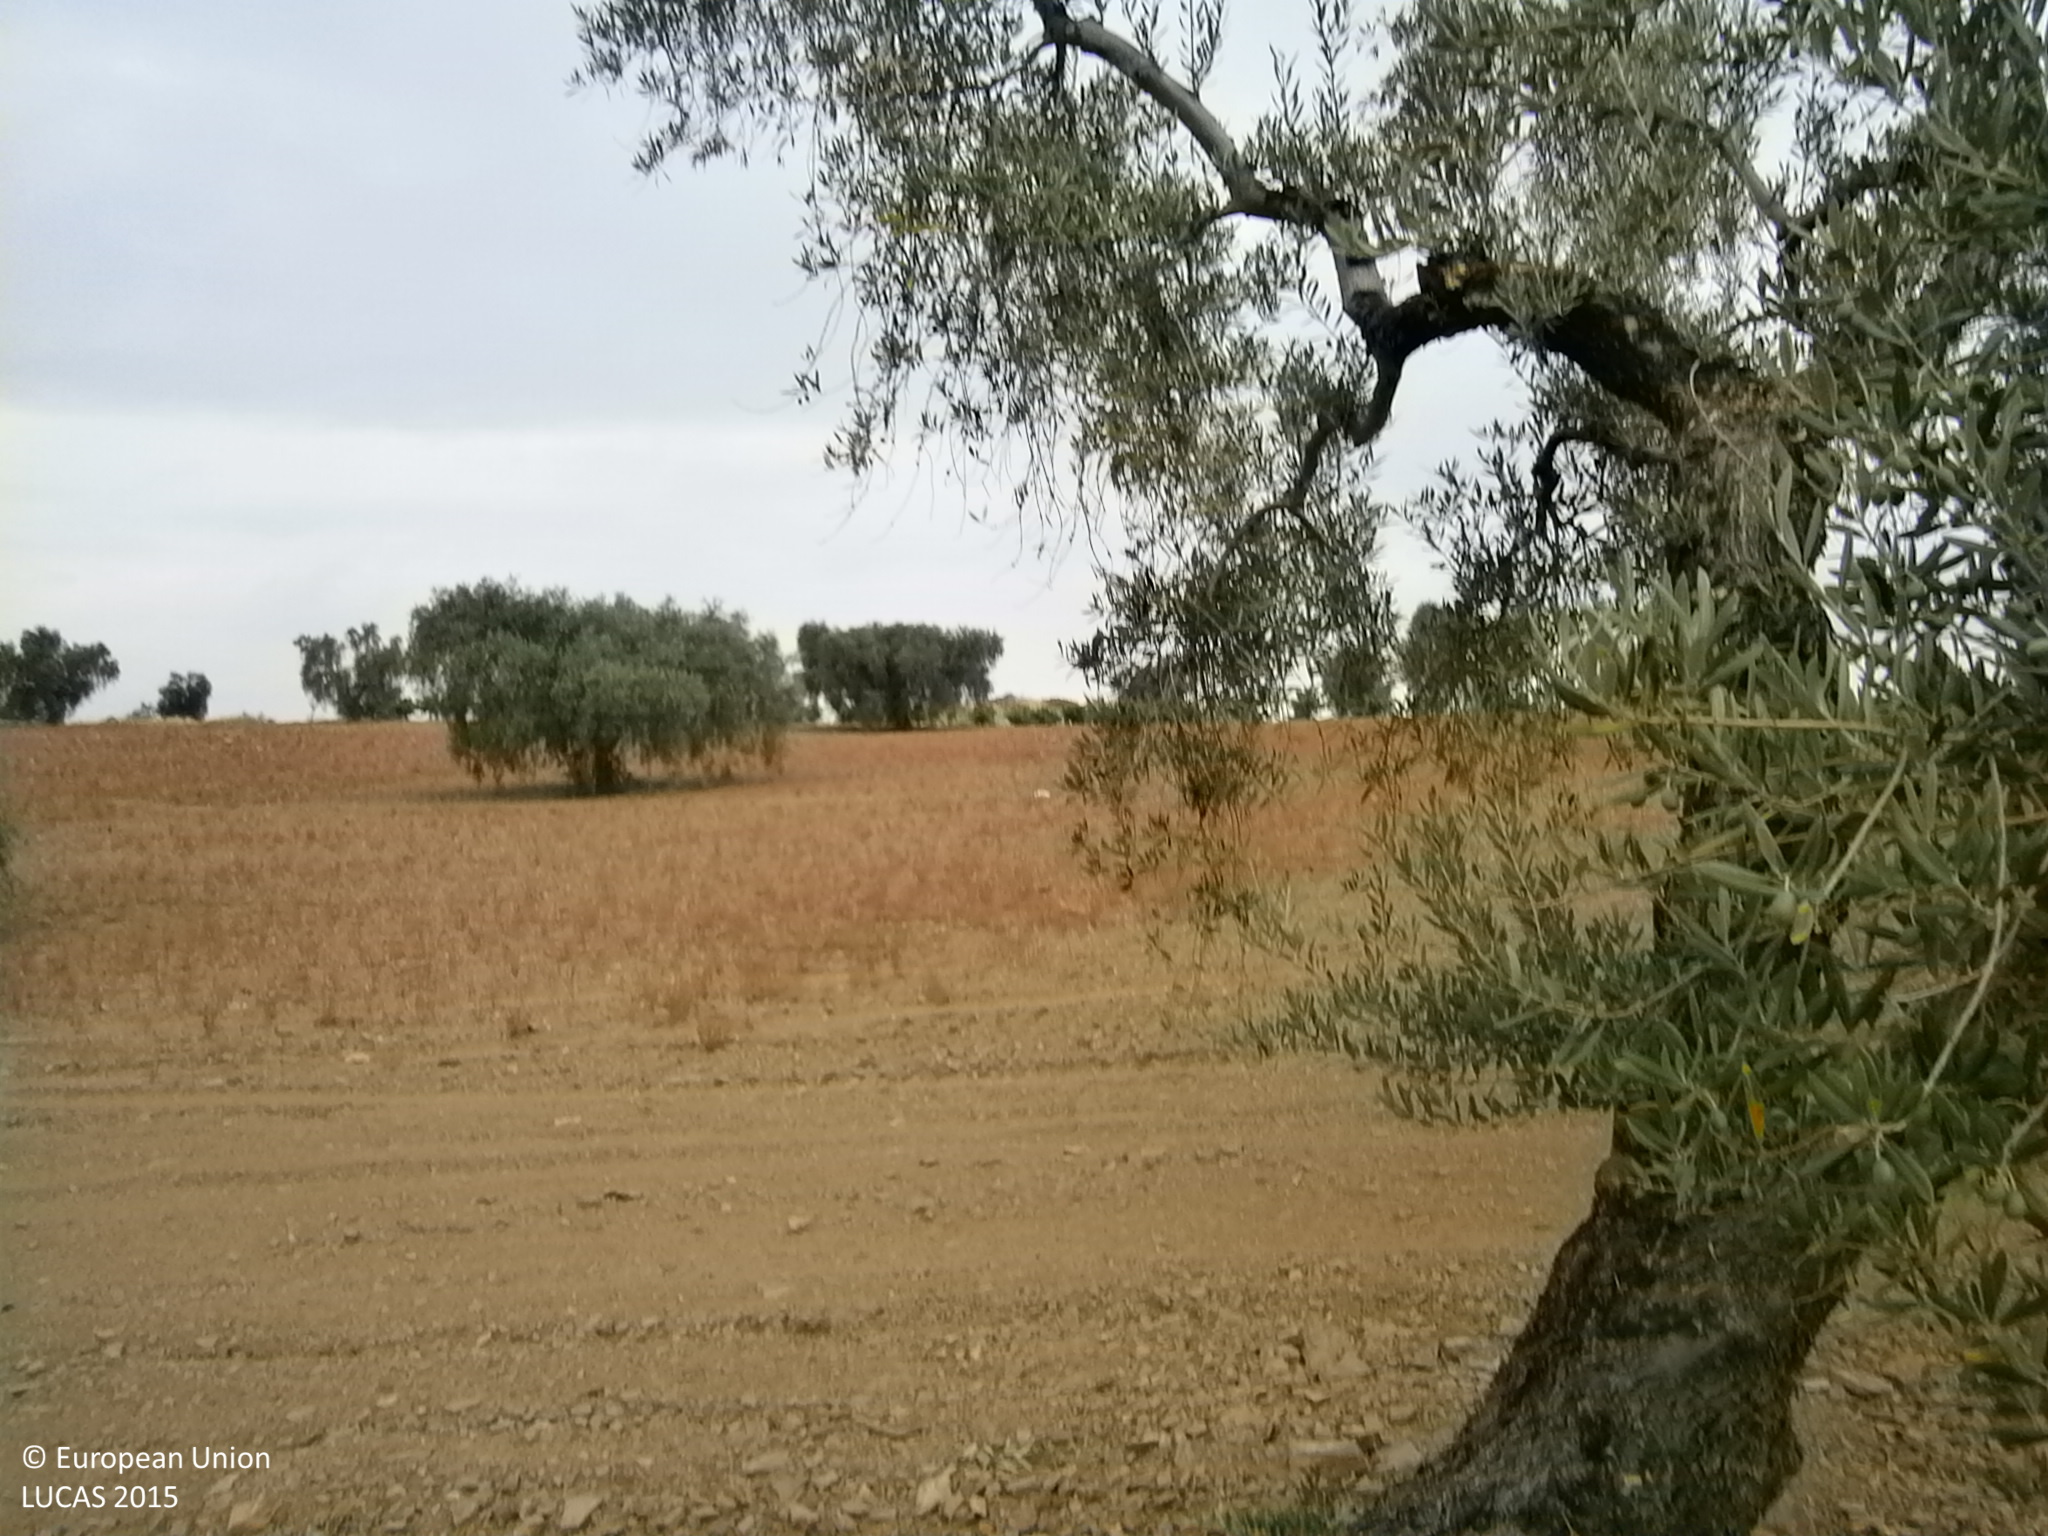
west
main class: Cropland
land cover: Olive groves
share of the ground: 10 - 25 %
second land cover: Other bare soil
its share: > 75 %
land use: Agriculture (excluding fallow land and kitchen gardens)
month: June
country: ES
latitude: 38.5899
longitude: -6.4600
